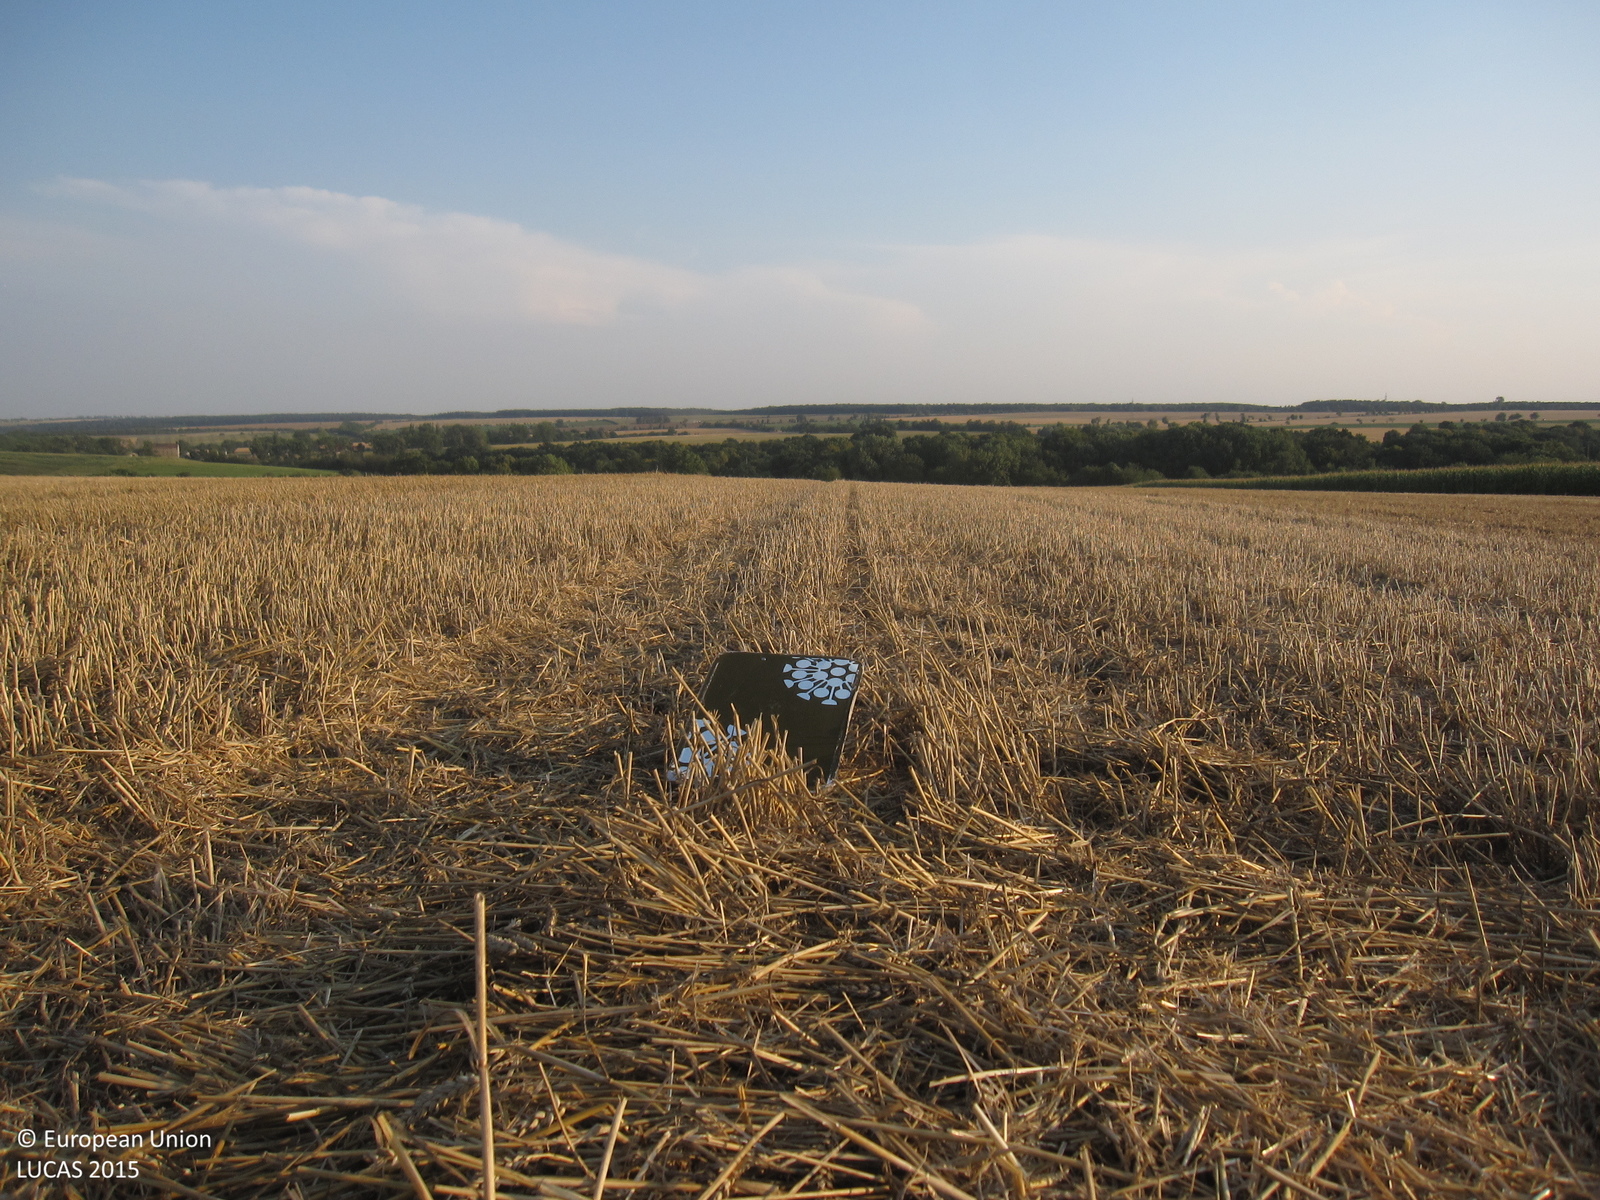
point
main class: Cropland
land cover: Common wheat
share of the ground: 50 - 75 %
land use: Agriculture (excluding fallow land and kitchen gardens)
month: August
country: DE
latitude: 51.3248
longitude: 11.5351
